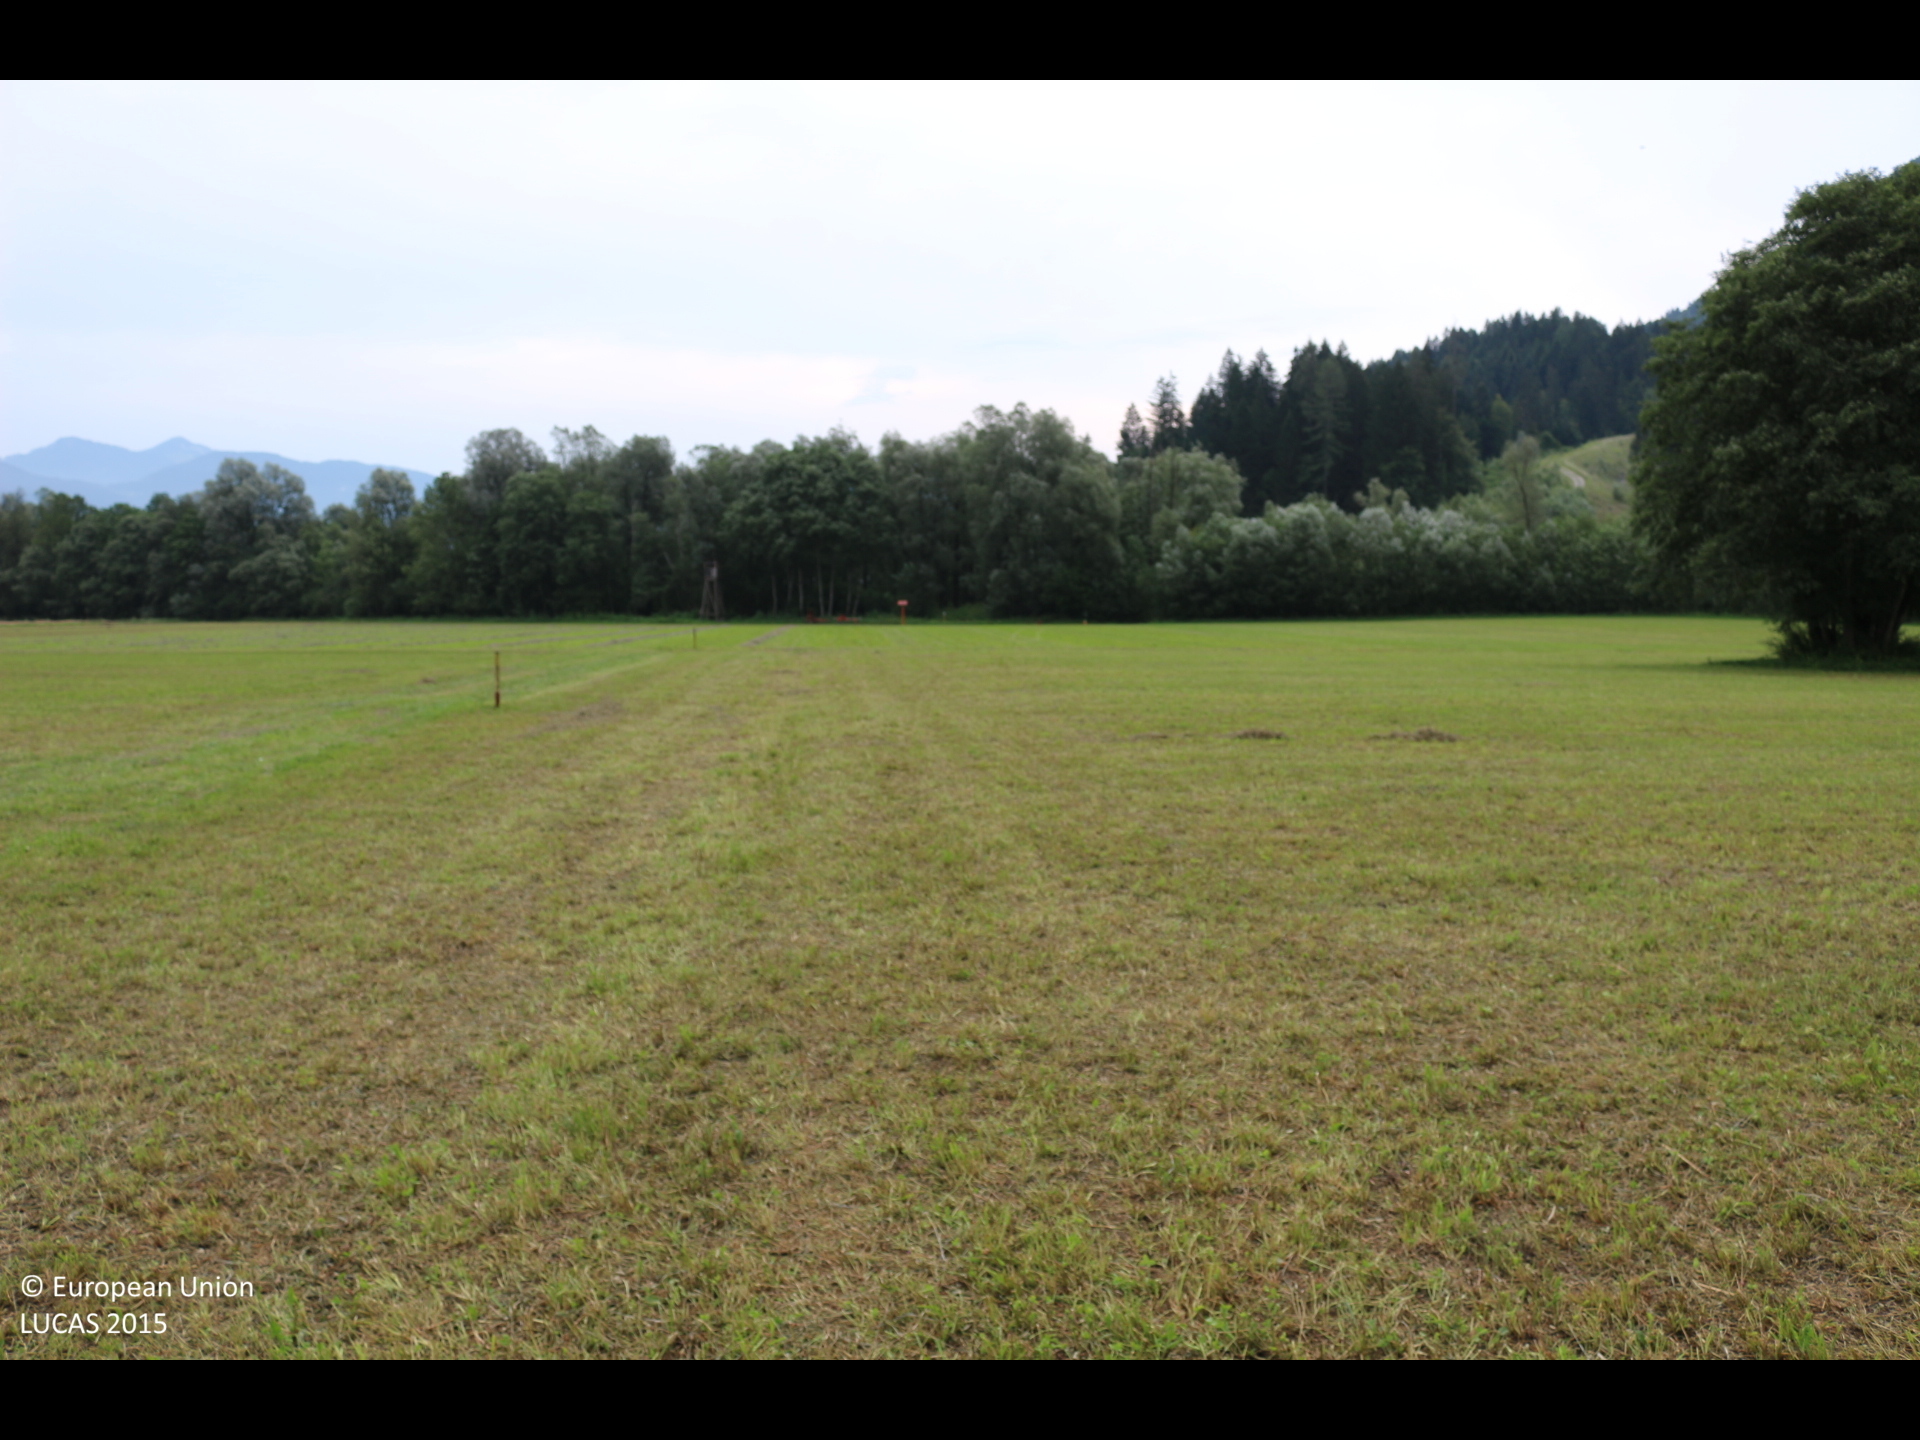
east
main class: Grassland
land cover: Grassland without tree/shrub cover
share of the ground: > 75 %
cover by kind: herbaceous plants 100 %
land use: Agriculture (excluding fallow land and kitchen gardens)
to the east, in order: Grassland without tree/shrub cover; Temporary grasslands; Broadleaved woodland; Rivers and streams; Broadleaved woodland; Grass margins; Tracks; Grassland without tree/shrub cover
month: August
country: AT
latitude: 46.6018
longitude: 13.4566
